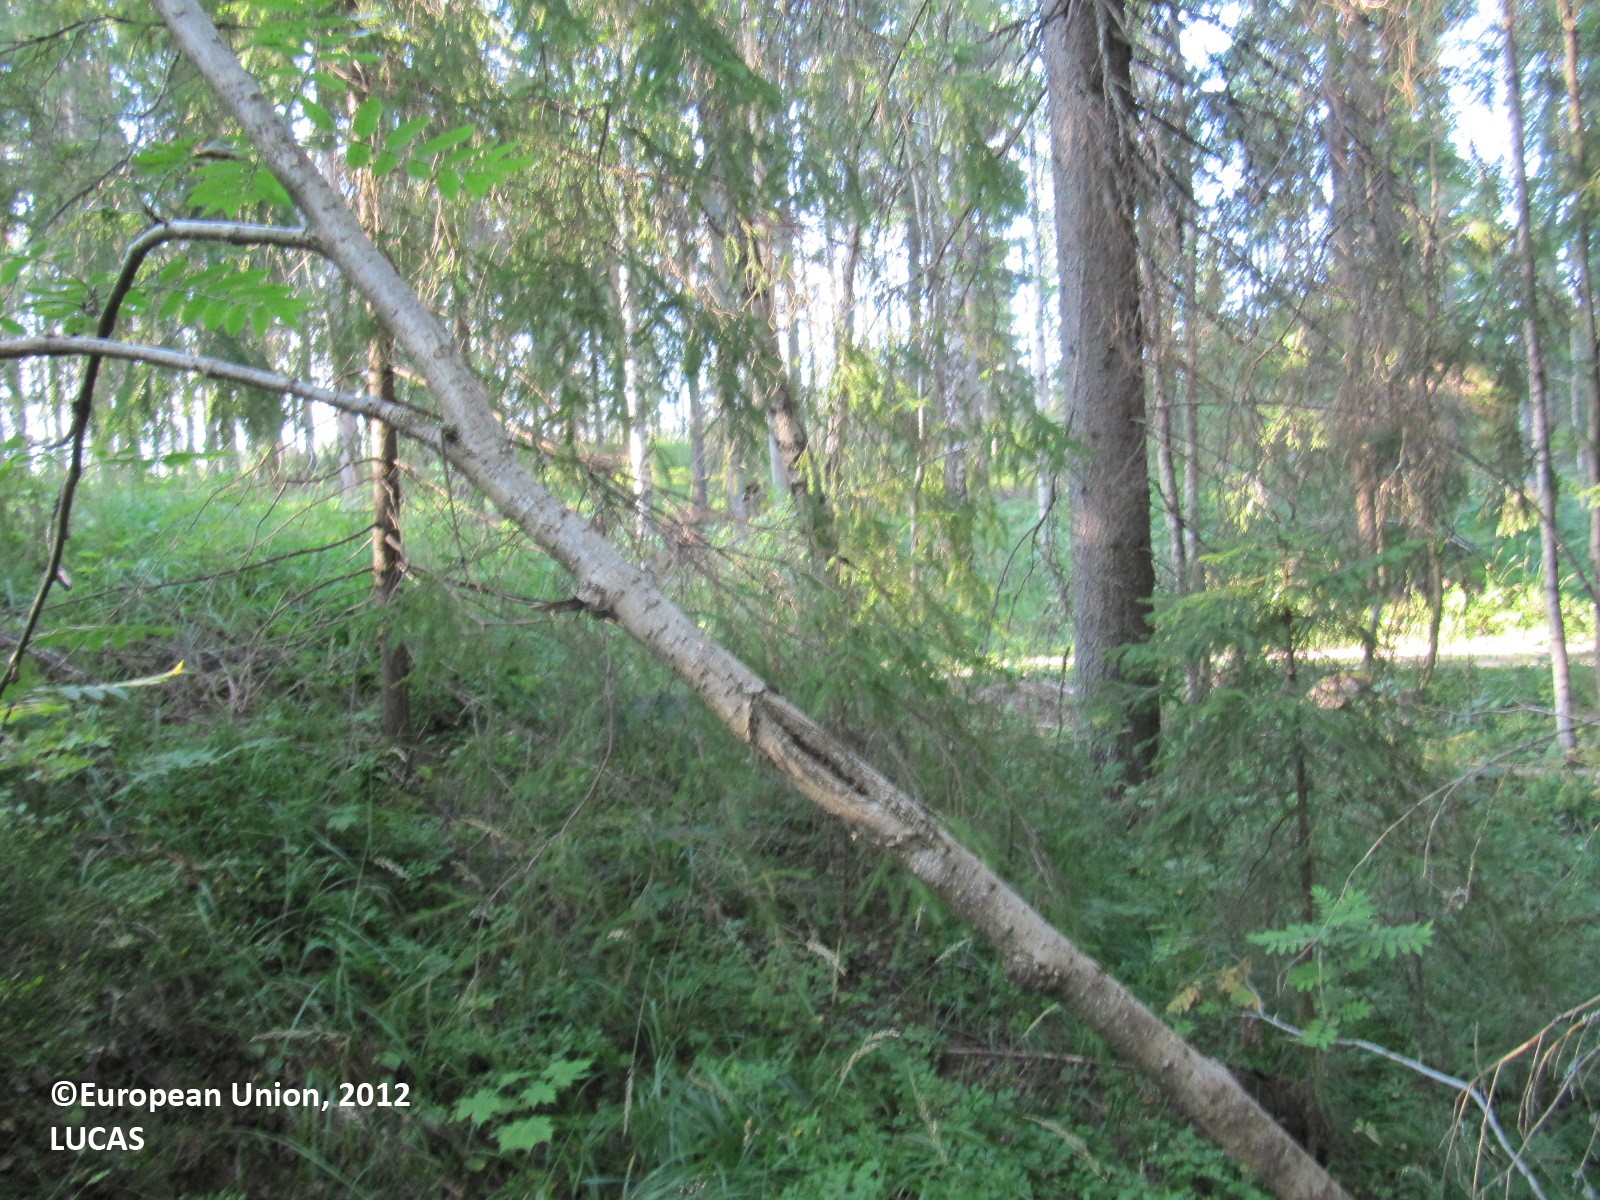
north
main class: Woodland
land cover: Spruce dominated mixed woodland
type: boreal forest
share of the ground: > 75 %
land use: Forestry
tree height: > 5 m
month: August
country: FI
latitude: 60.5426
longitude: 24.5261
